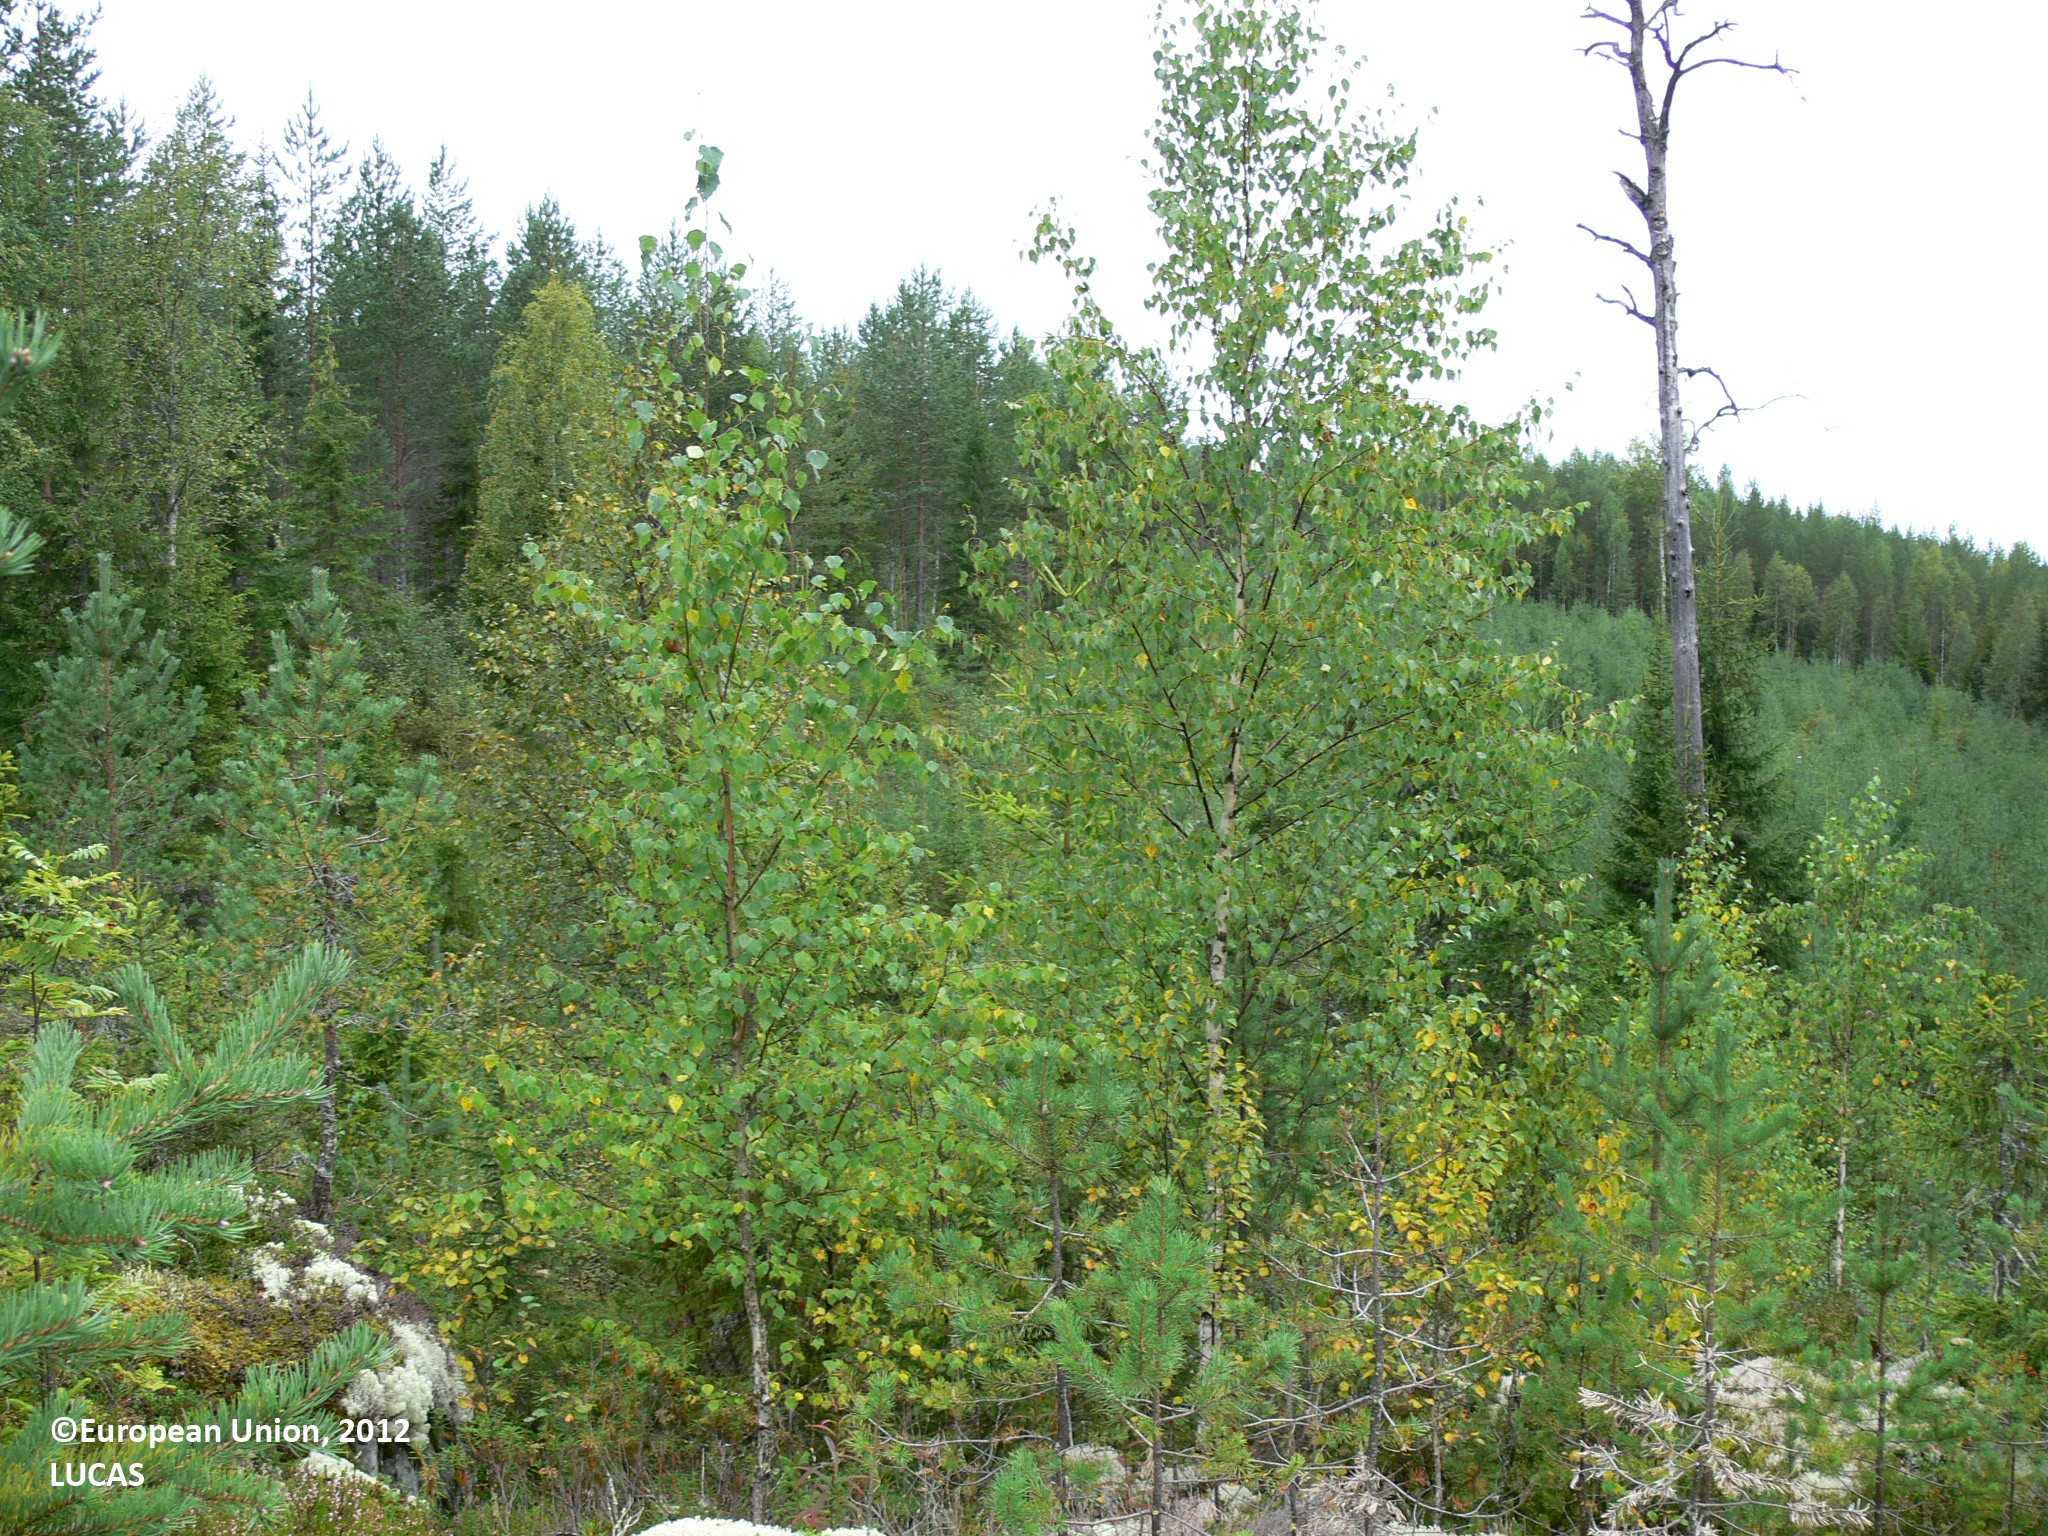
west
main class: Woodland
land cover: Pine dominated mixed woodland
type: boreal forest
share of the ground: 25 - 50 %
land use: Forestry
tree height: < 5 m
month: August
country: FI
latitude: 63.1712
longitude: 30.1795
